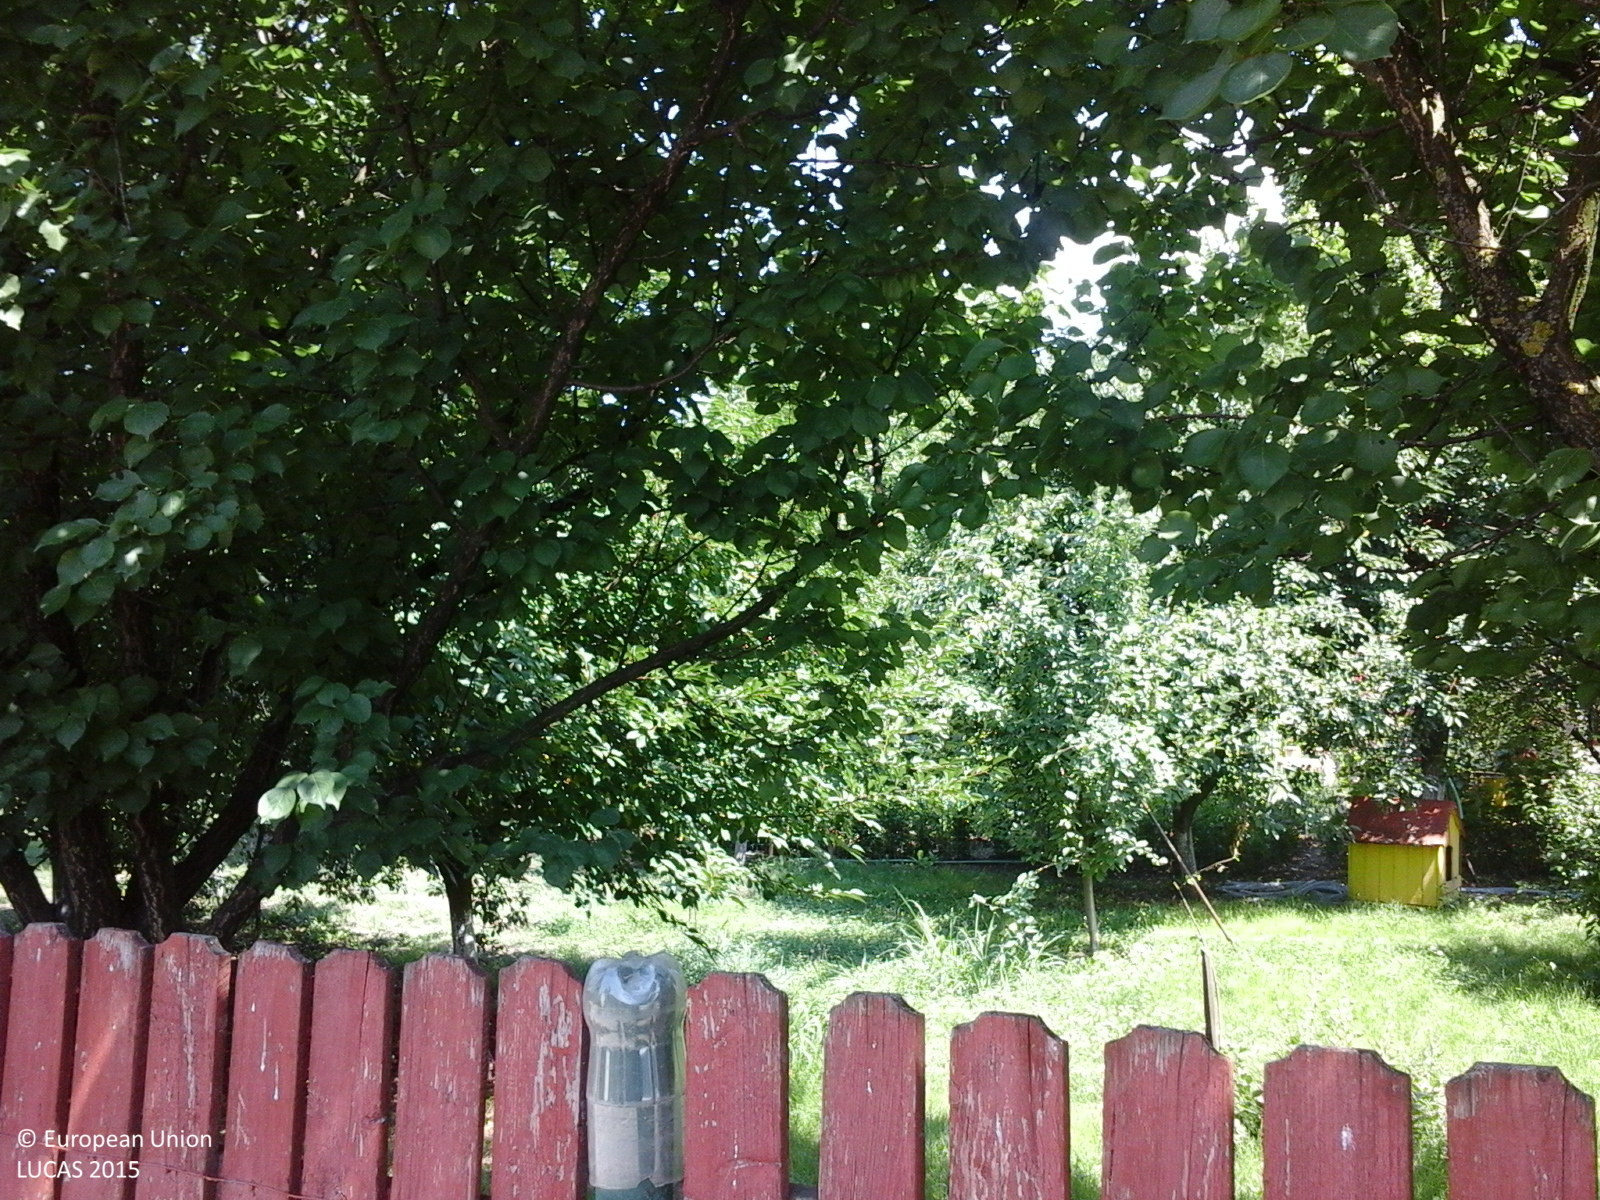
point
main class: Cropland
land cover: Apple fruit
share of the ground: 50 - 75 %
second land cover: Grassland without tree/shrub cover
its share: > 75 %
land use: Agriculture (excluding fallow land and kitchen gardens)
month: July
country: RO
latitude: 43.8976
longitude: 25.9439
